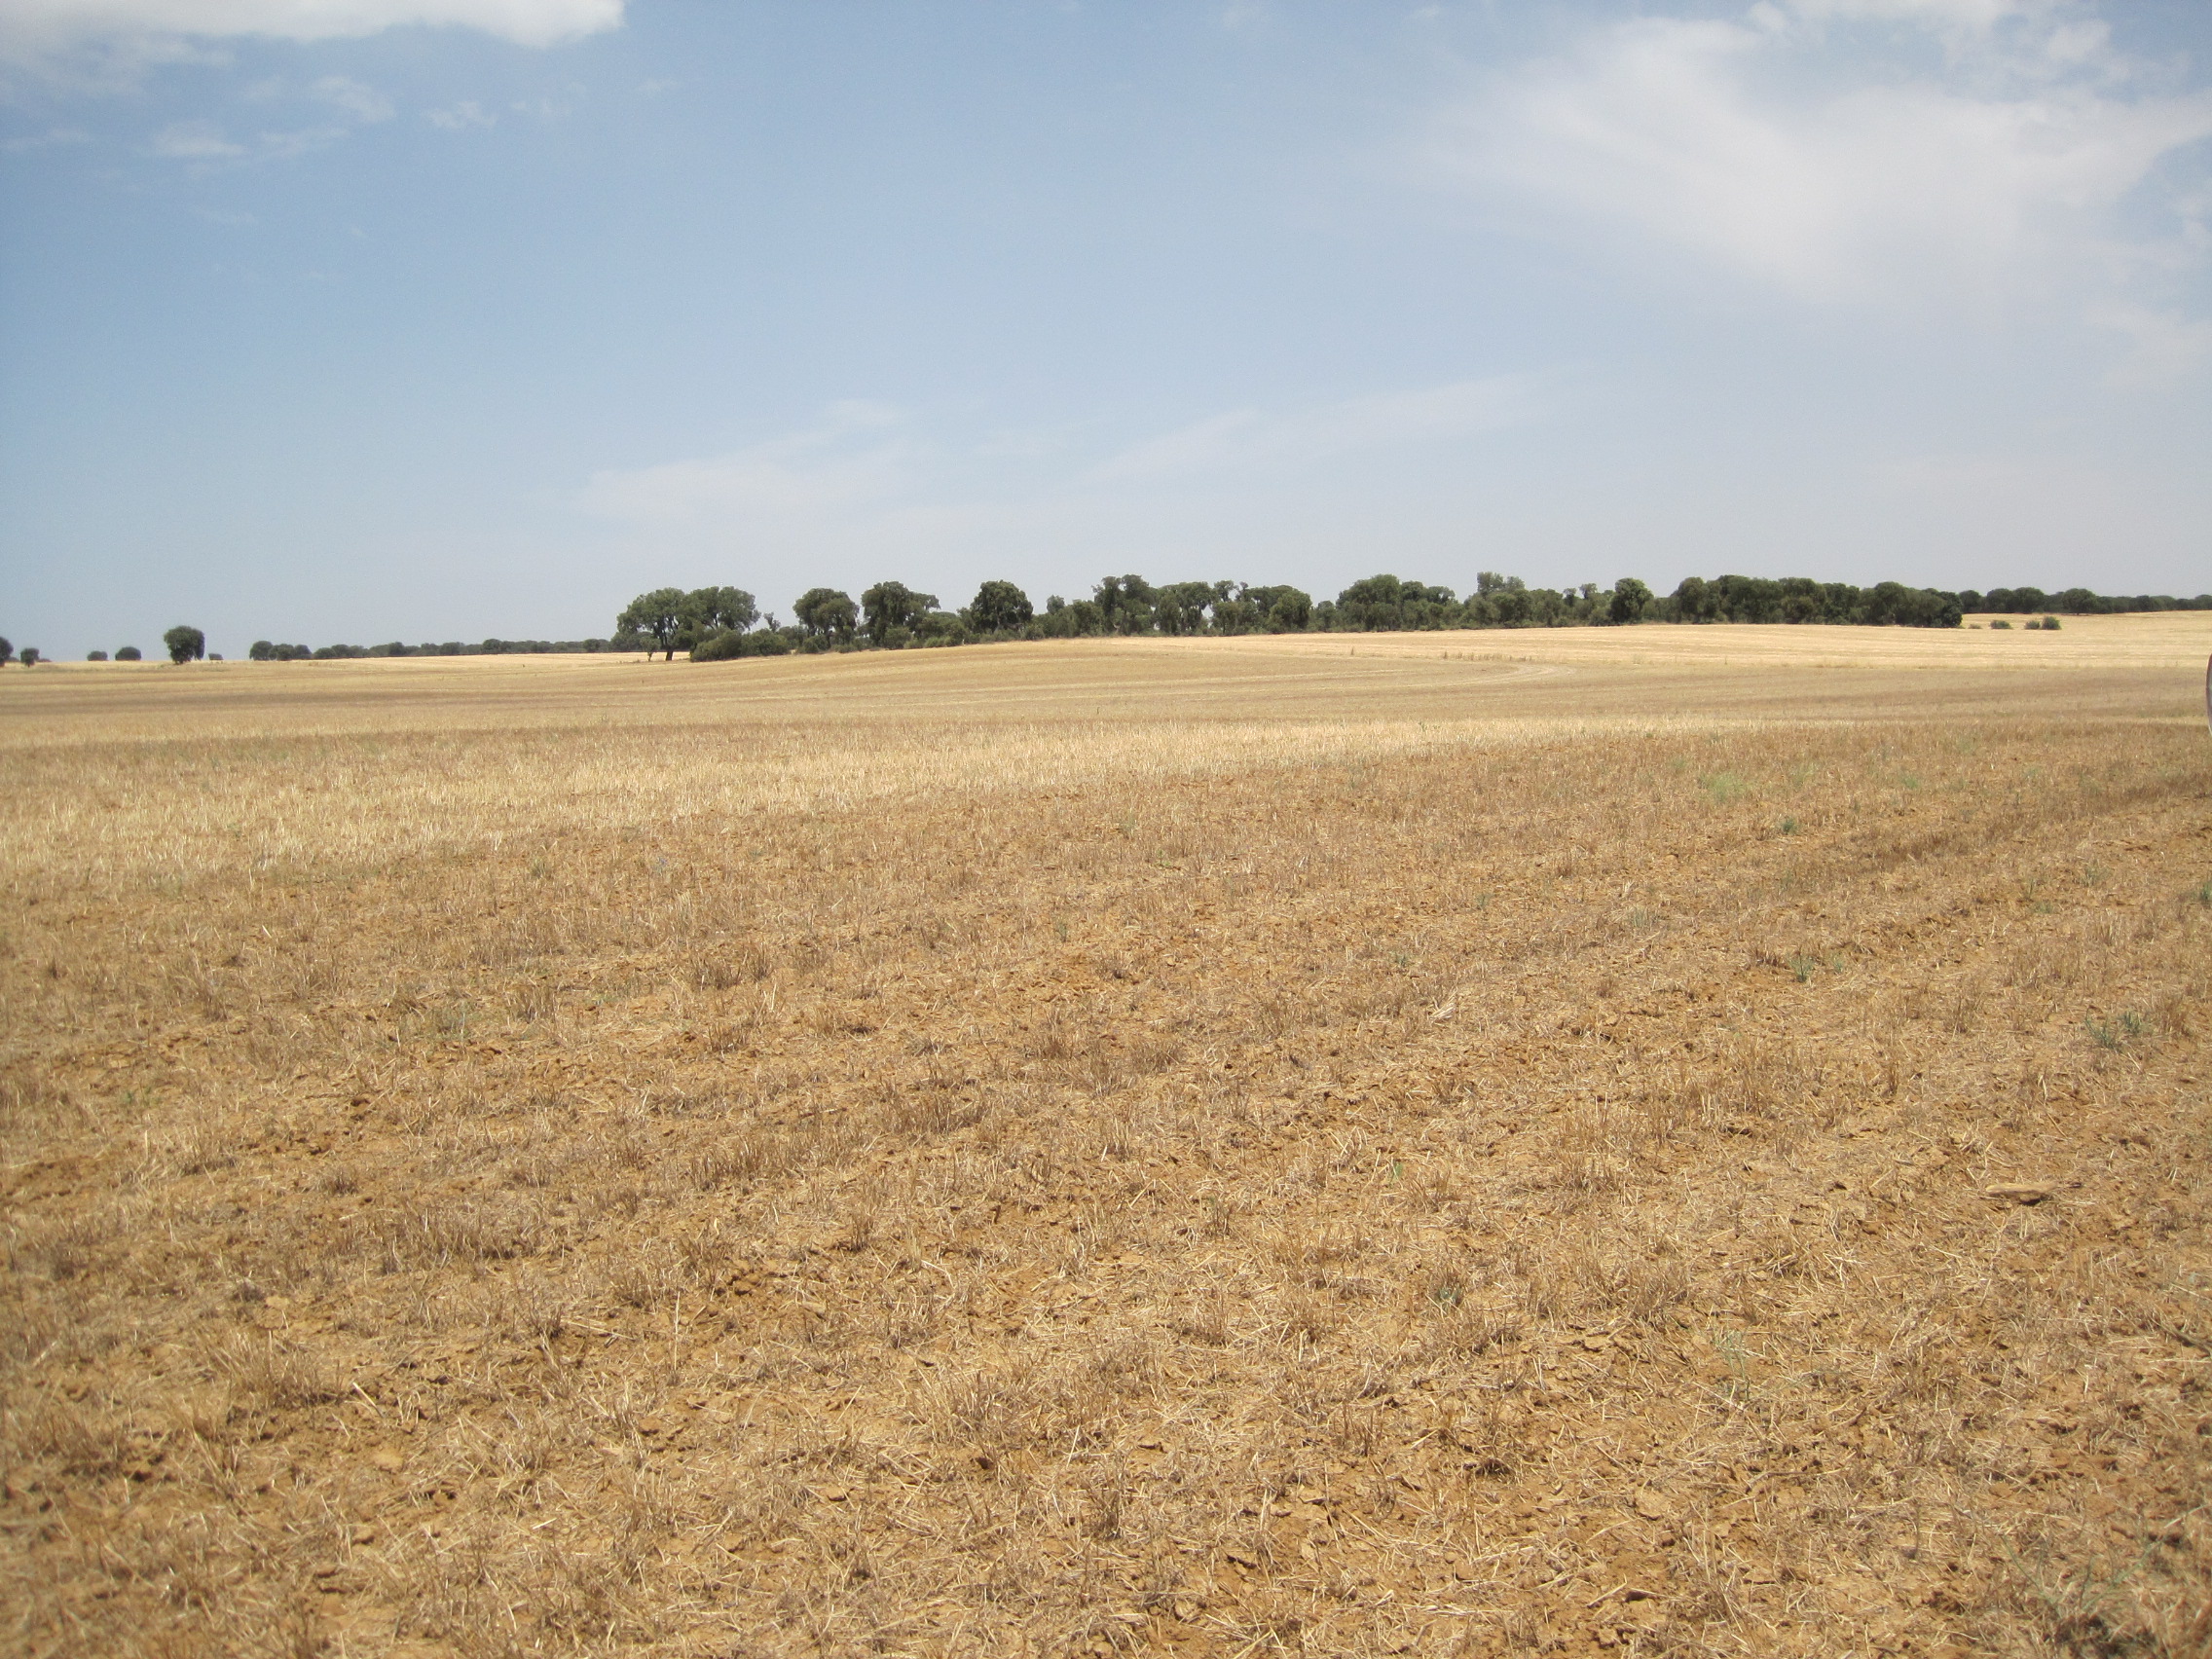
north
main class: Cropland
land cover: Dry pulses
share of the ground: < 10 %
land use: Agriculture (excluding fallow land and kitchen gardens)
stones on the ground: 10 - 25 %
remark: Harvested field
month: July
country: ES
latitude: 41.7544
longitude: -5.5645
